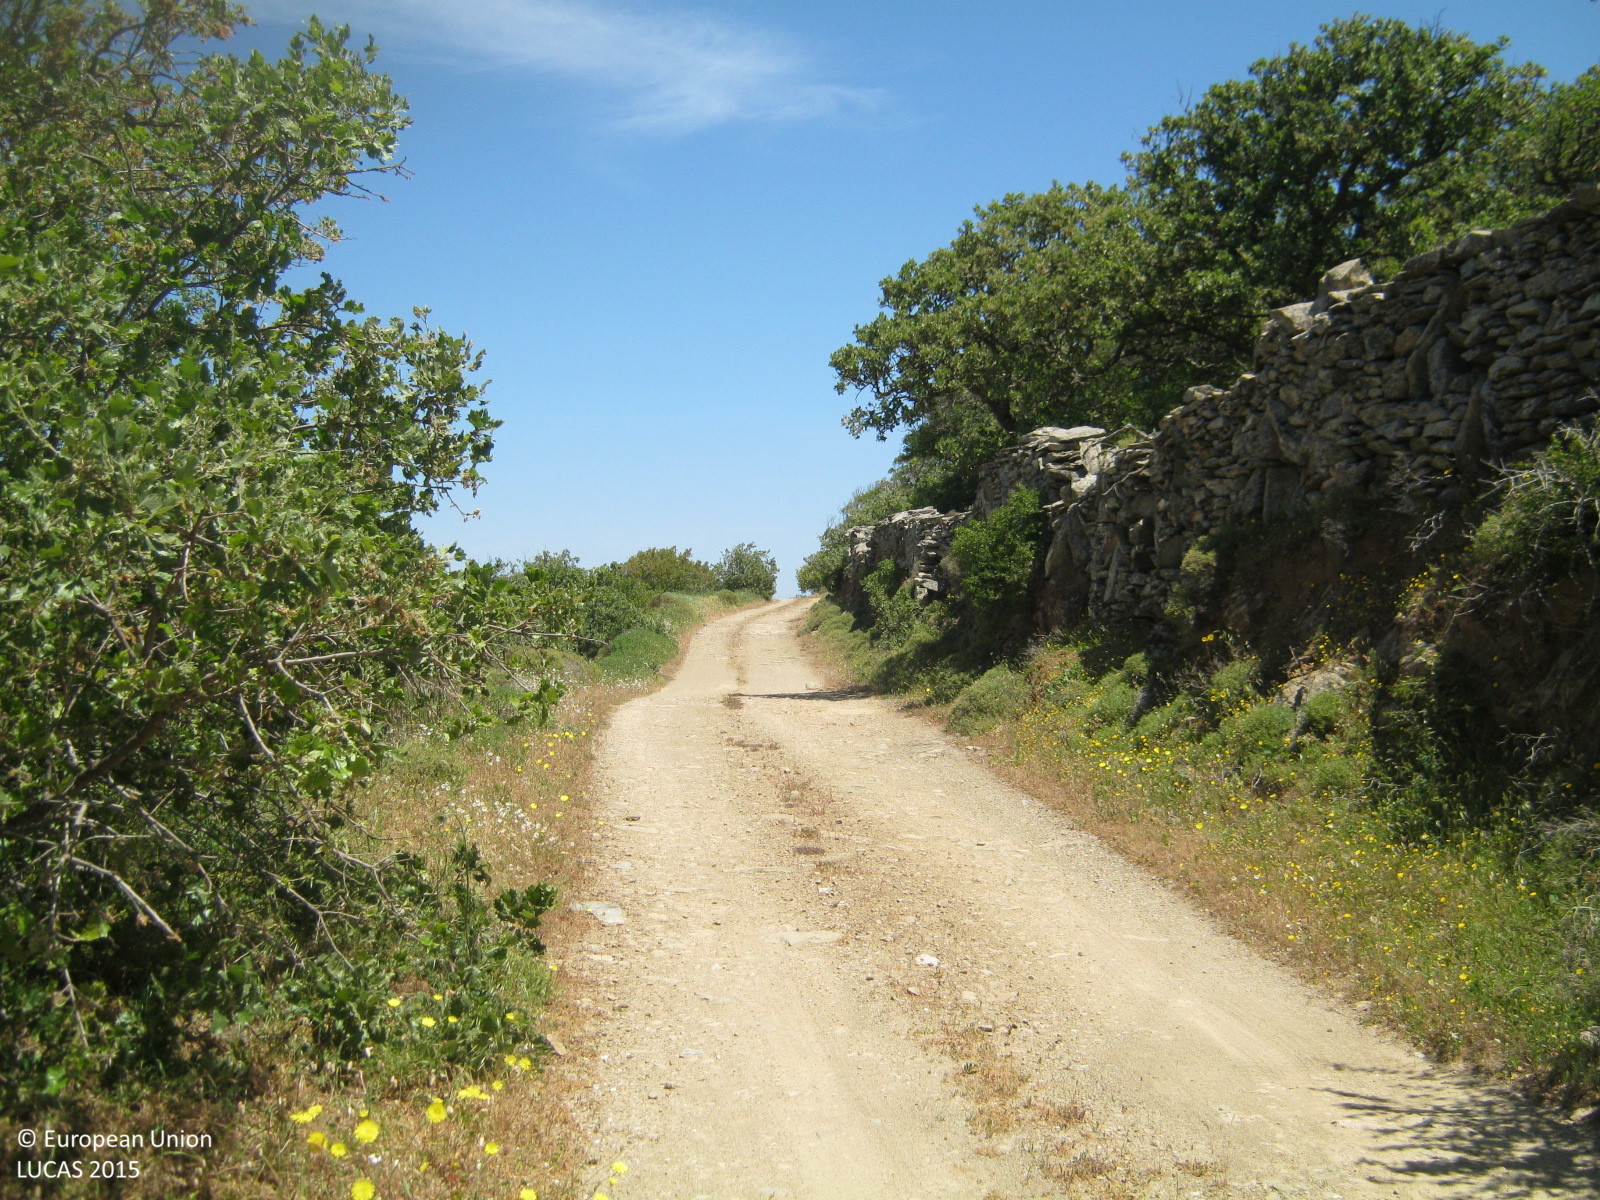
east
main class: Woodland
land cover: Broadleaved woodland
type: thermophilous deciduous forest
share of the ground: > 75 %
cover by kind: broadleaved forest trees 75 %, herbaceous plants 10 %, unconsolidated bare surface 10 %, shrubs 5 %
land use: Semi-natural and natural areas not in use
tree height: > 5 m
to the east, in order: Broadleaved woodland; Fences; Grass margins; Tracks; Abandoned hedges; Dry stone walls; Broadleaved woodland; Shrubland with sparse tree cover; Dry stone walls; Shrubland with sparse tree cover; Dry stone walls; Shrubland without tree cover; Dry stone walls; Grass margins; Tracks; Grass margins; Dry stone walls; Broadleaved woodland; Grass margins; Tracks; Grass margins; Fences; Shrubland with sparse tree cover
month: May
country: GR
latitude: 37.6079
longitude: 24.3568
